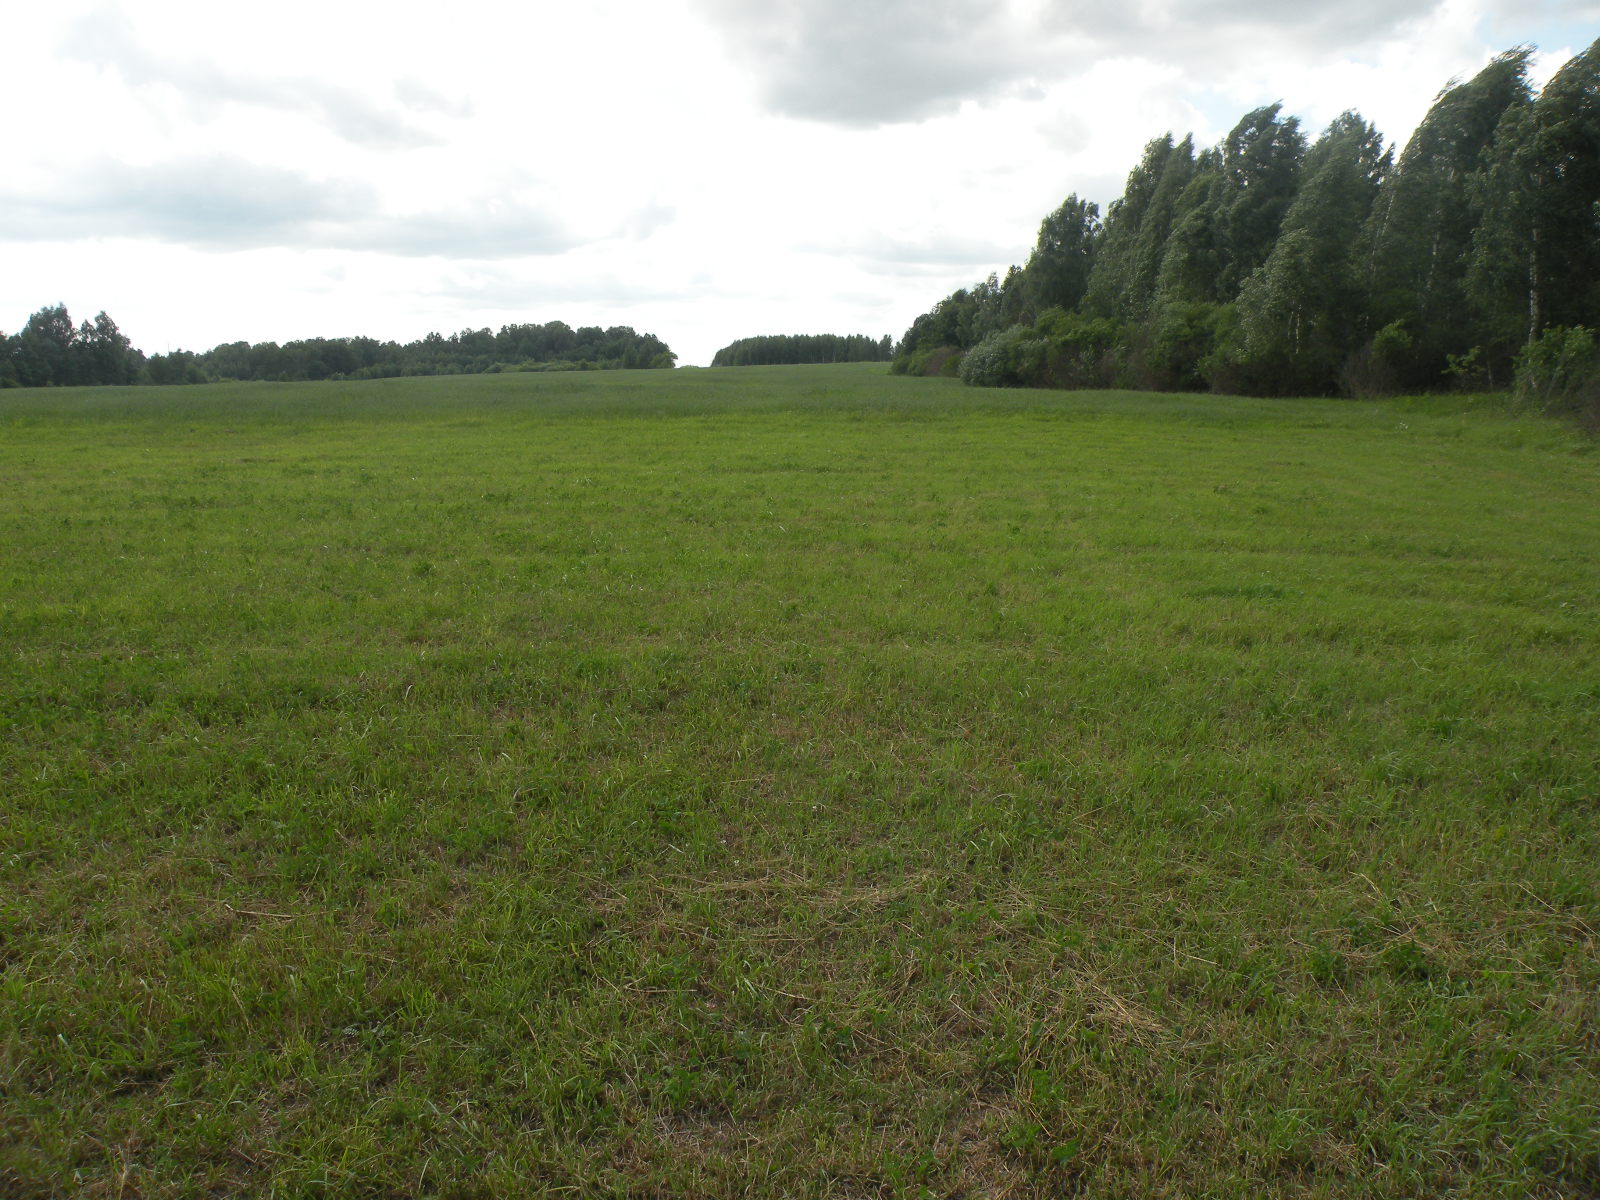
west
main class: Grassland
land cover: Grassland without tree/shrub cover
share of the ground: > 75 %
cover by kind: herbaceous plants 75 %, unconsolidated bare surface 25 %
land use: Agriculture (excluding fallow land and kitchen gardens)
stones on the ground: < 10 %
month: July
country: LV
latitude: 55.8335
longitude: 26.5824
